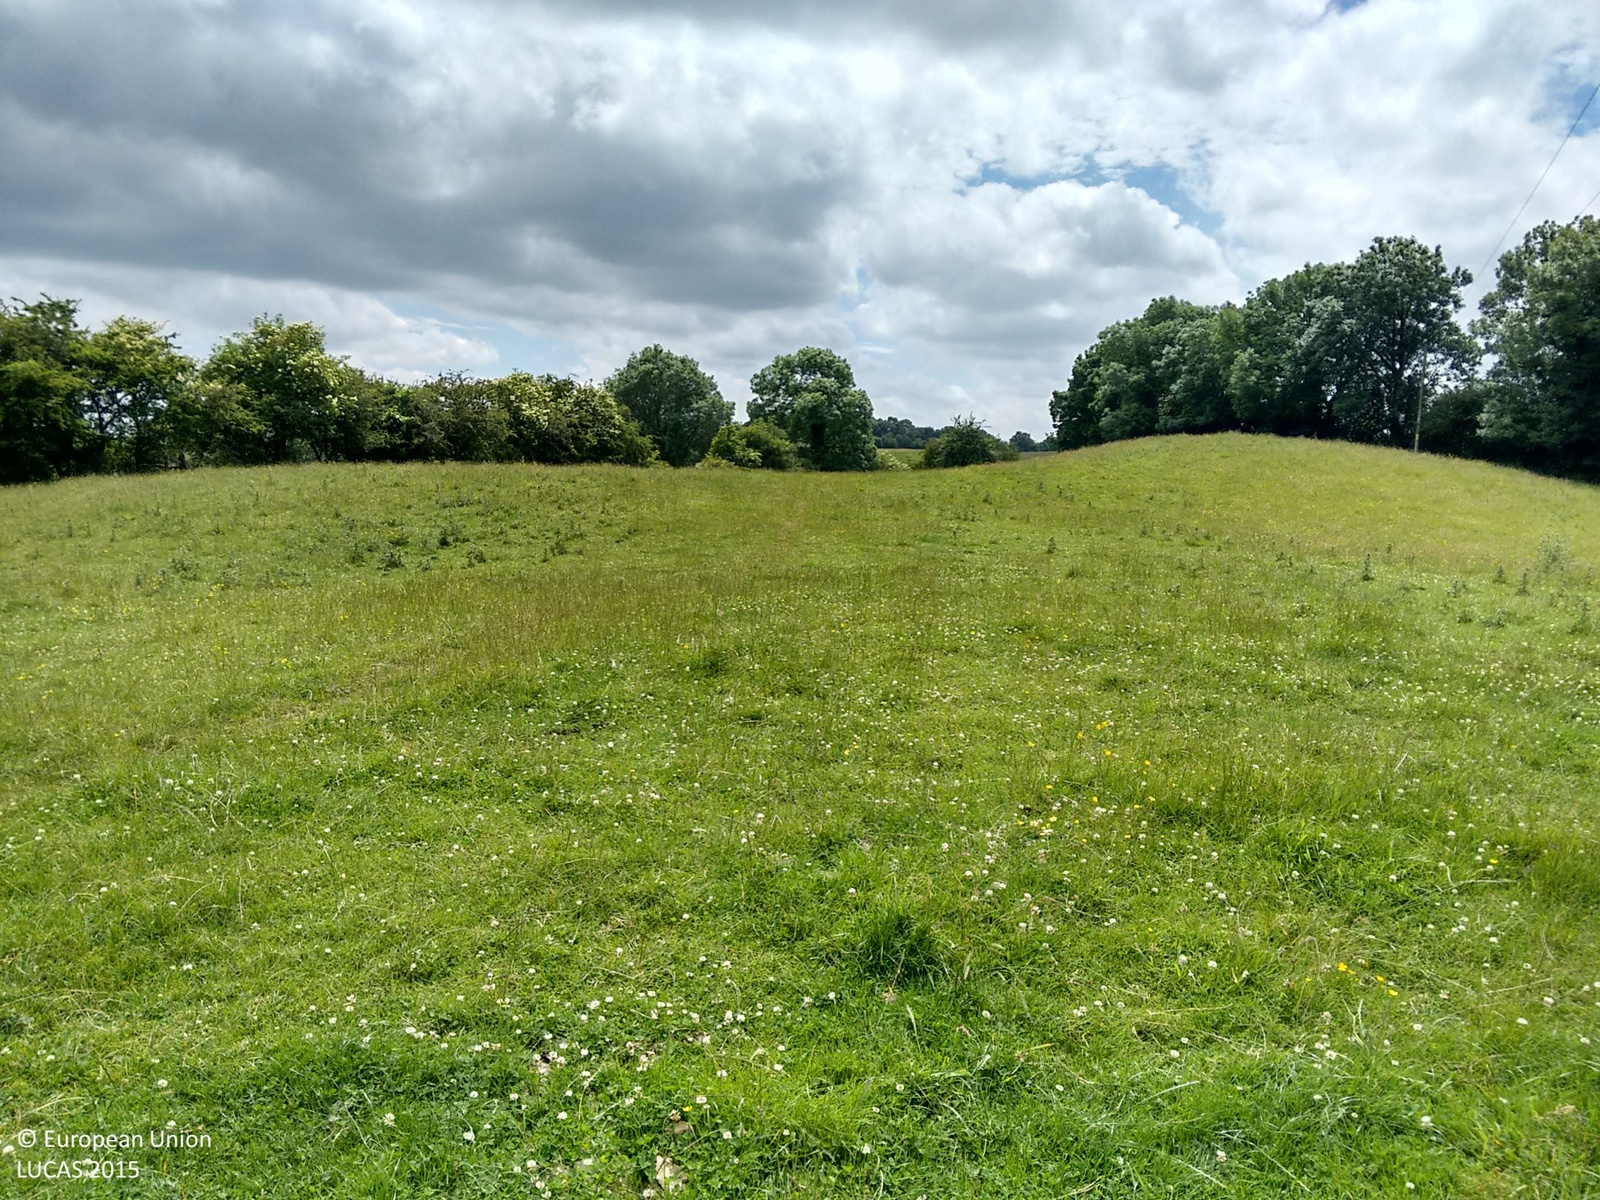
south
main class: Grassland
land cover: Grassland without tree/shrub cover
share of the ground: > 75 %
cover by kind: herbaceous plants 100 %
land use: Agriculture (excluding fallow land and kitchen gardens)
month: June
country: IE
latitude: 53.6704
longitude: -7.0503
